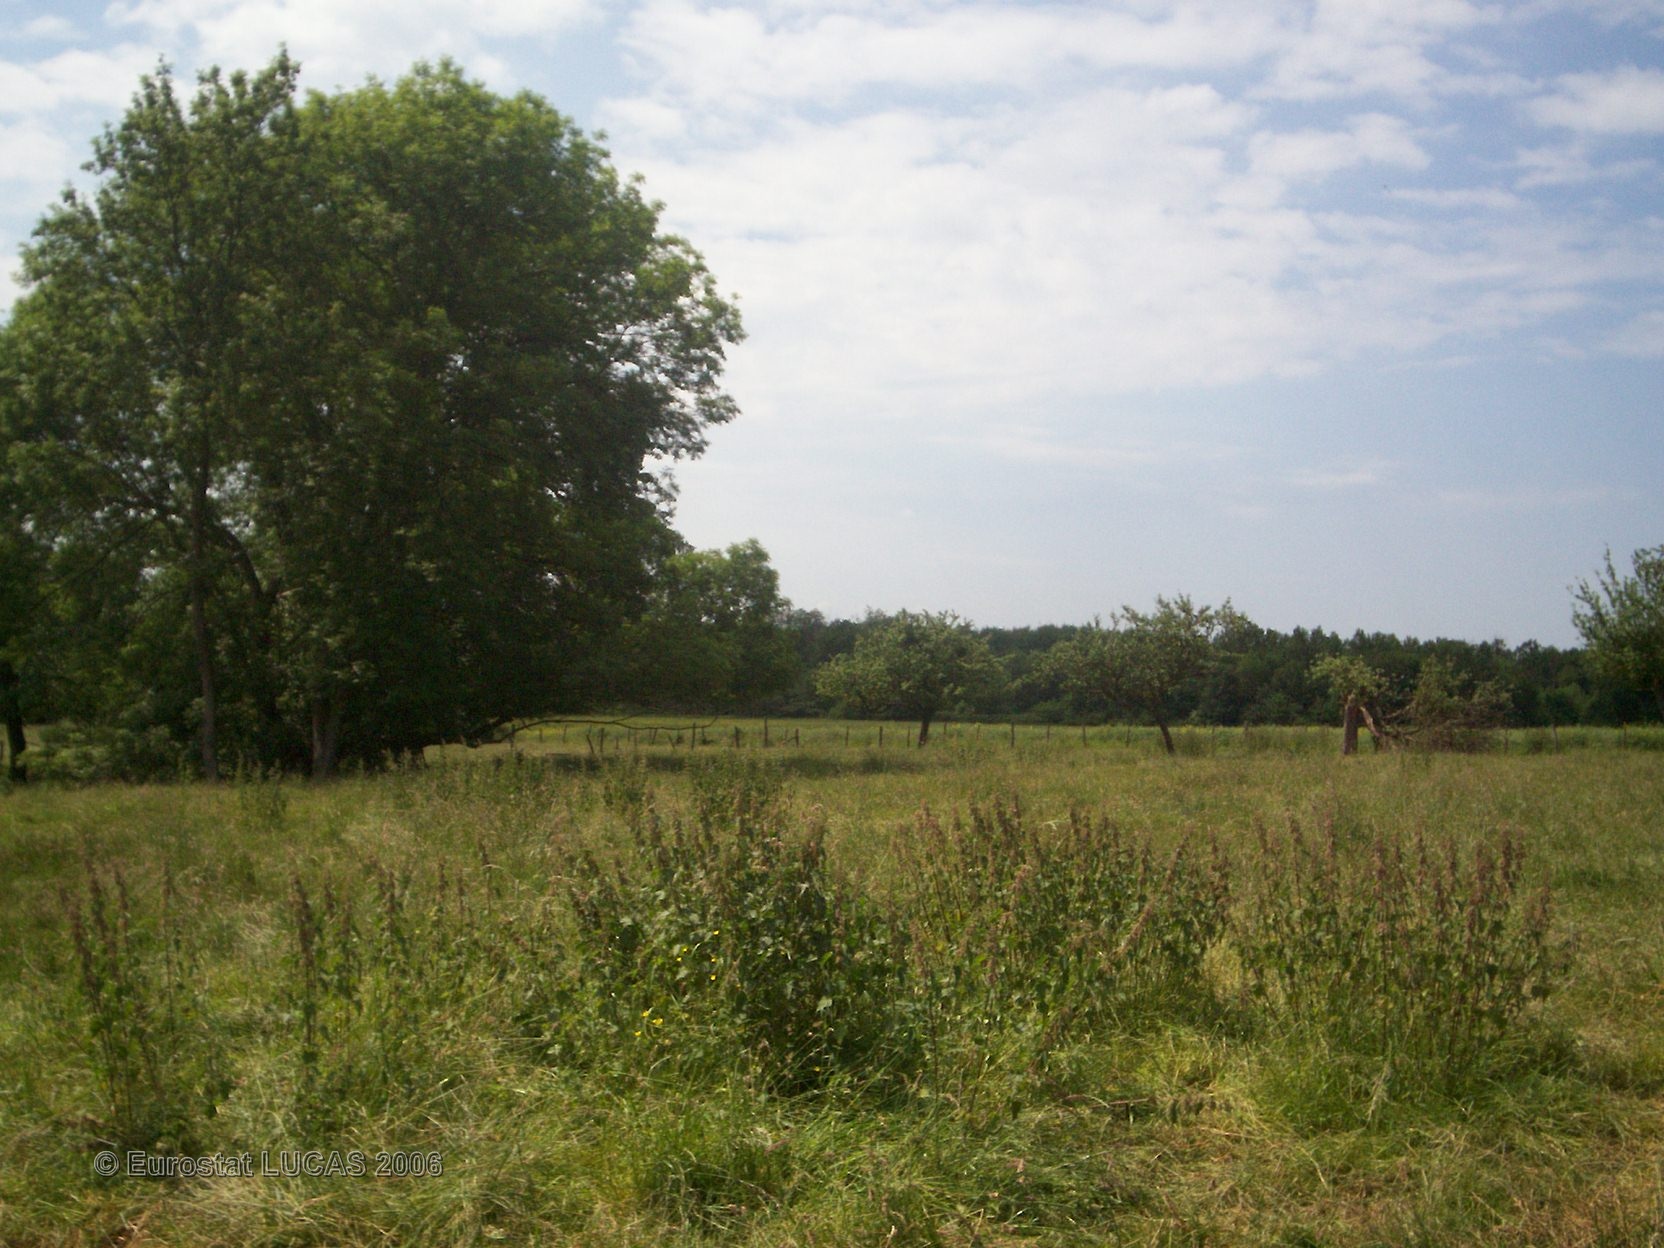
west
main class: Grassland
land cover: Grassland with sparse tree/shrub cover
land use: Agriculture (excluding fallow land and kitchen gardens)
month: June
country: FR
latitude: 49.4065
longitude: 2.6709
